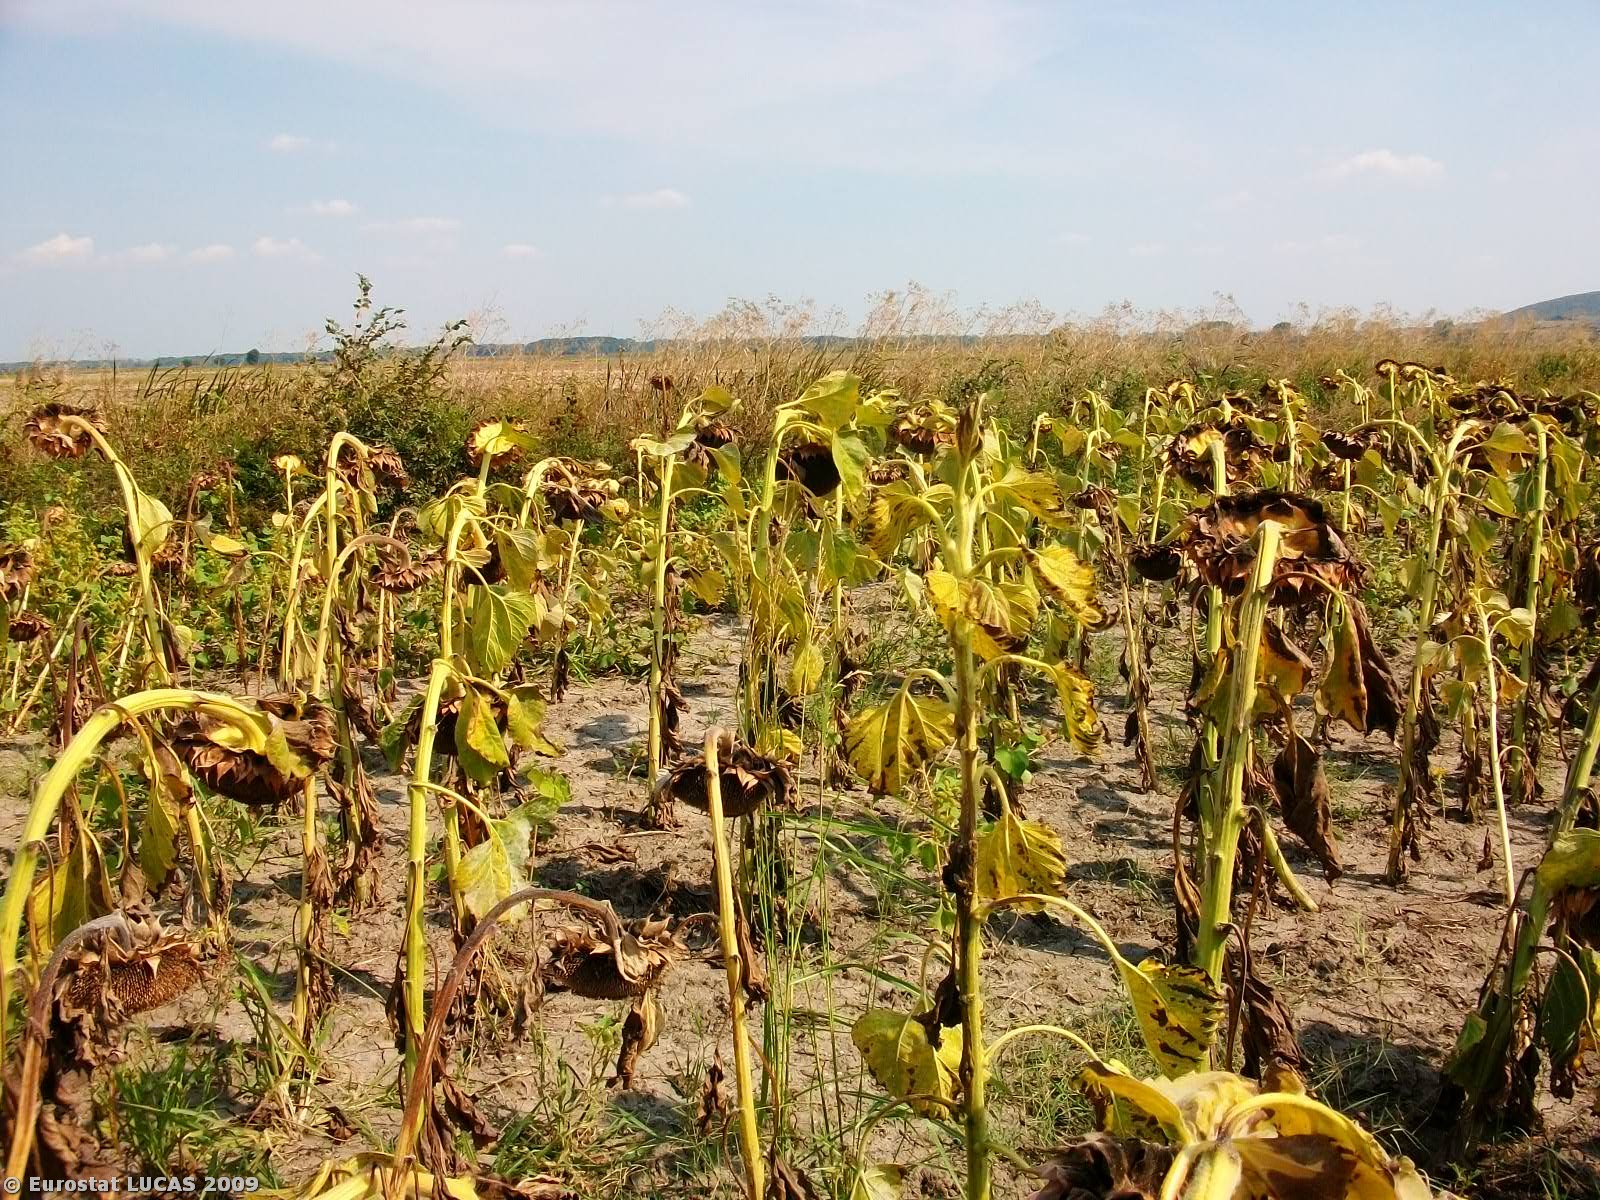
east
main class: Cropland
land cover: Sunflower
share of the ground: > 75 %
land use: Agriculture (excluding fallow land and kitchen gardens)
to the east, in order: Sunflower; Shruby margins; Ditches and canals; Shruby margins; Common wheat; Grass margins; Tracks; Grass margins; Common wheat
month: September
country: GR
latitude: 40.9933
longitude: 26.2930
